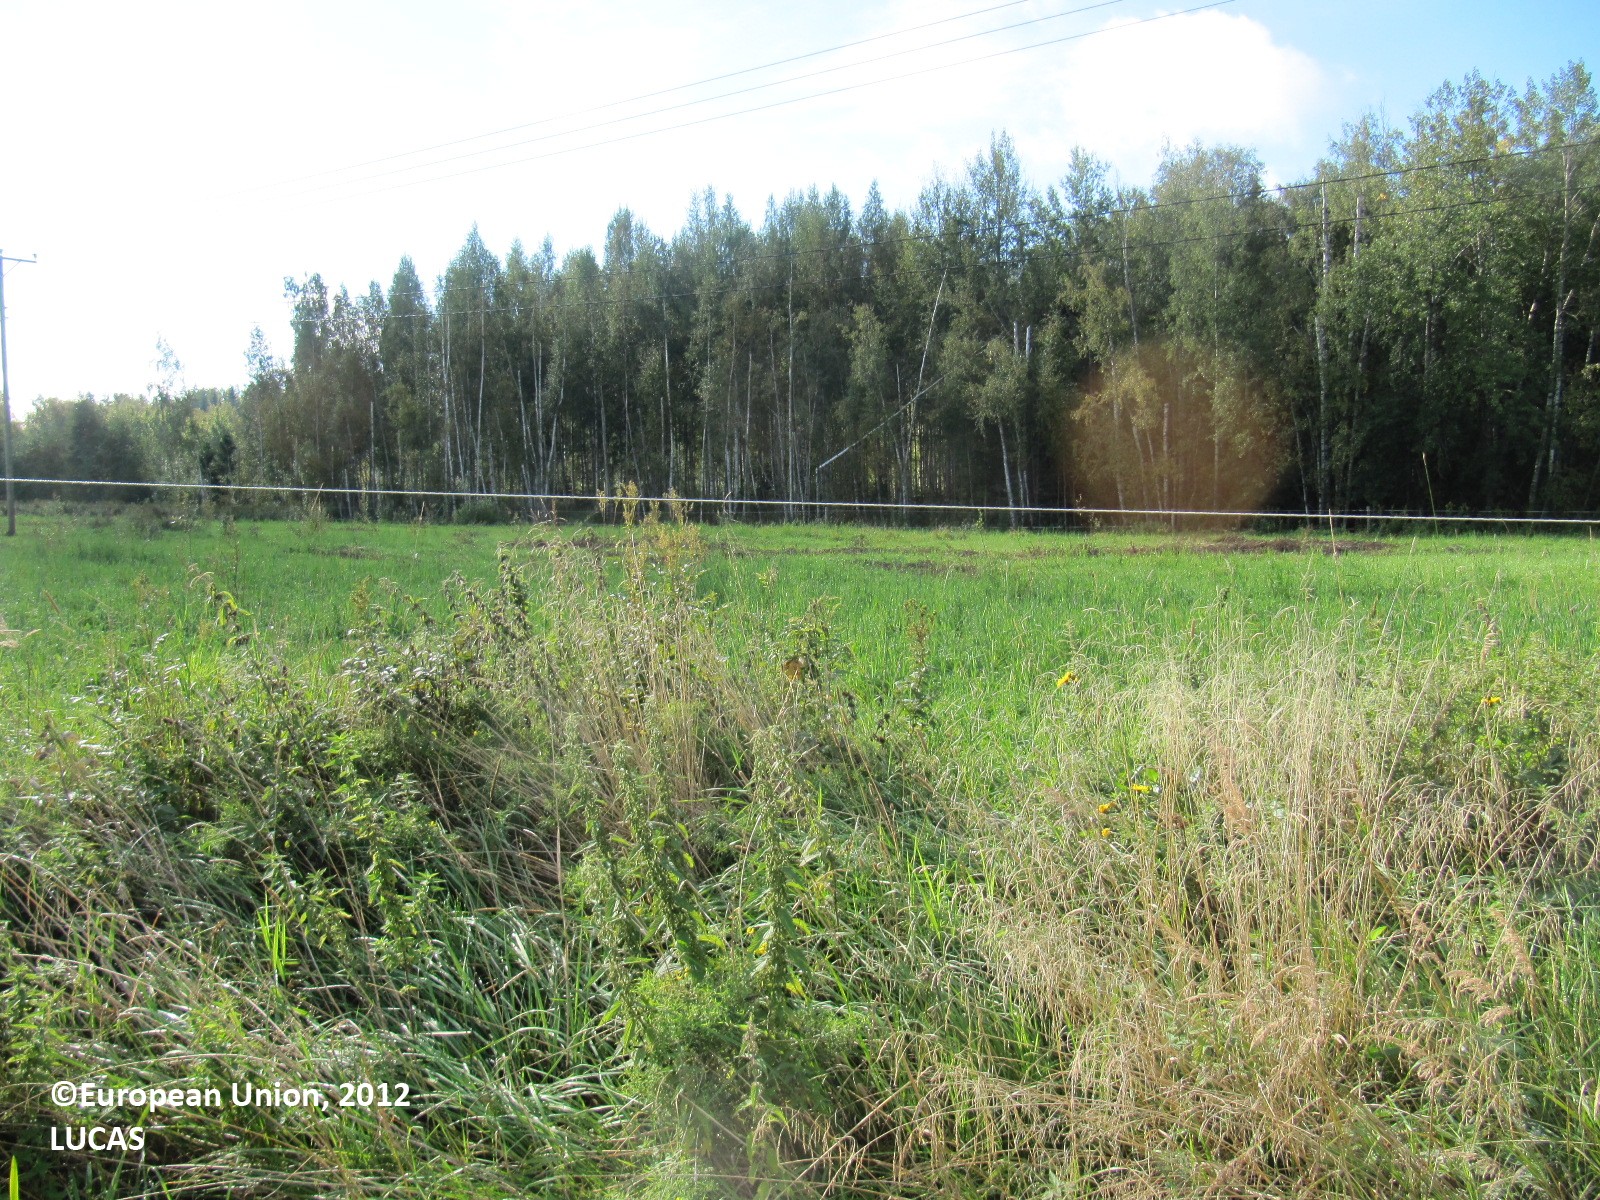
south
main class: Grassland
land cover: Grassland without tree/shrub cover
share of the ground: > 75 %
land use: Fallow land
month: September
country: FI
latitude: 60.7857
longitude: 23.3618
